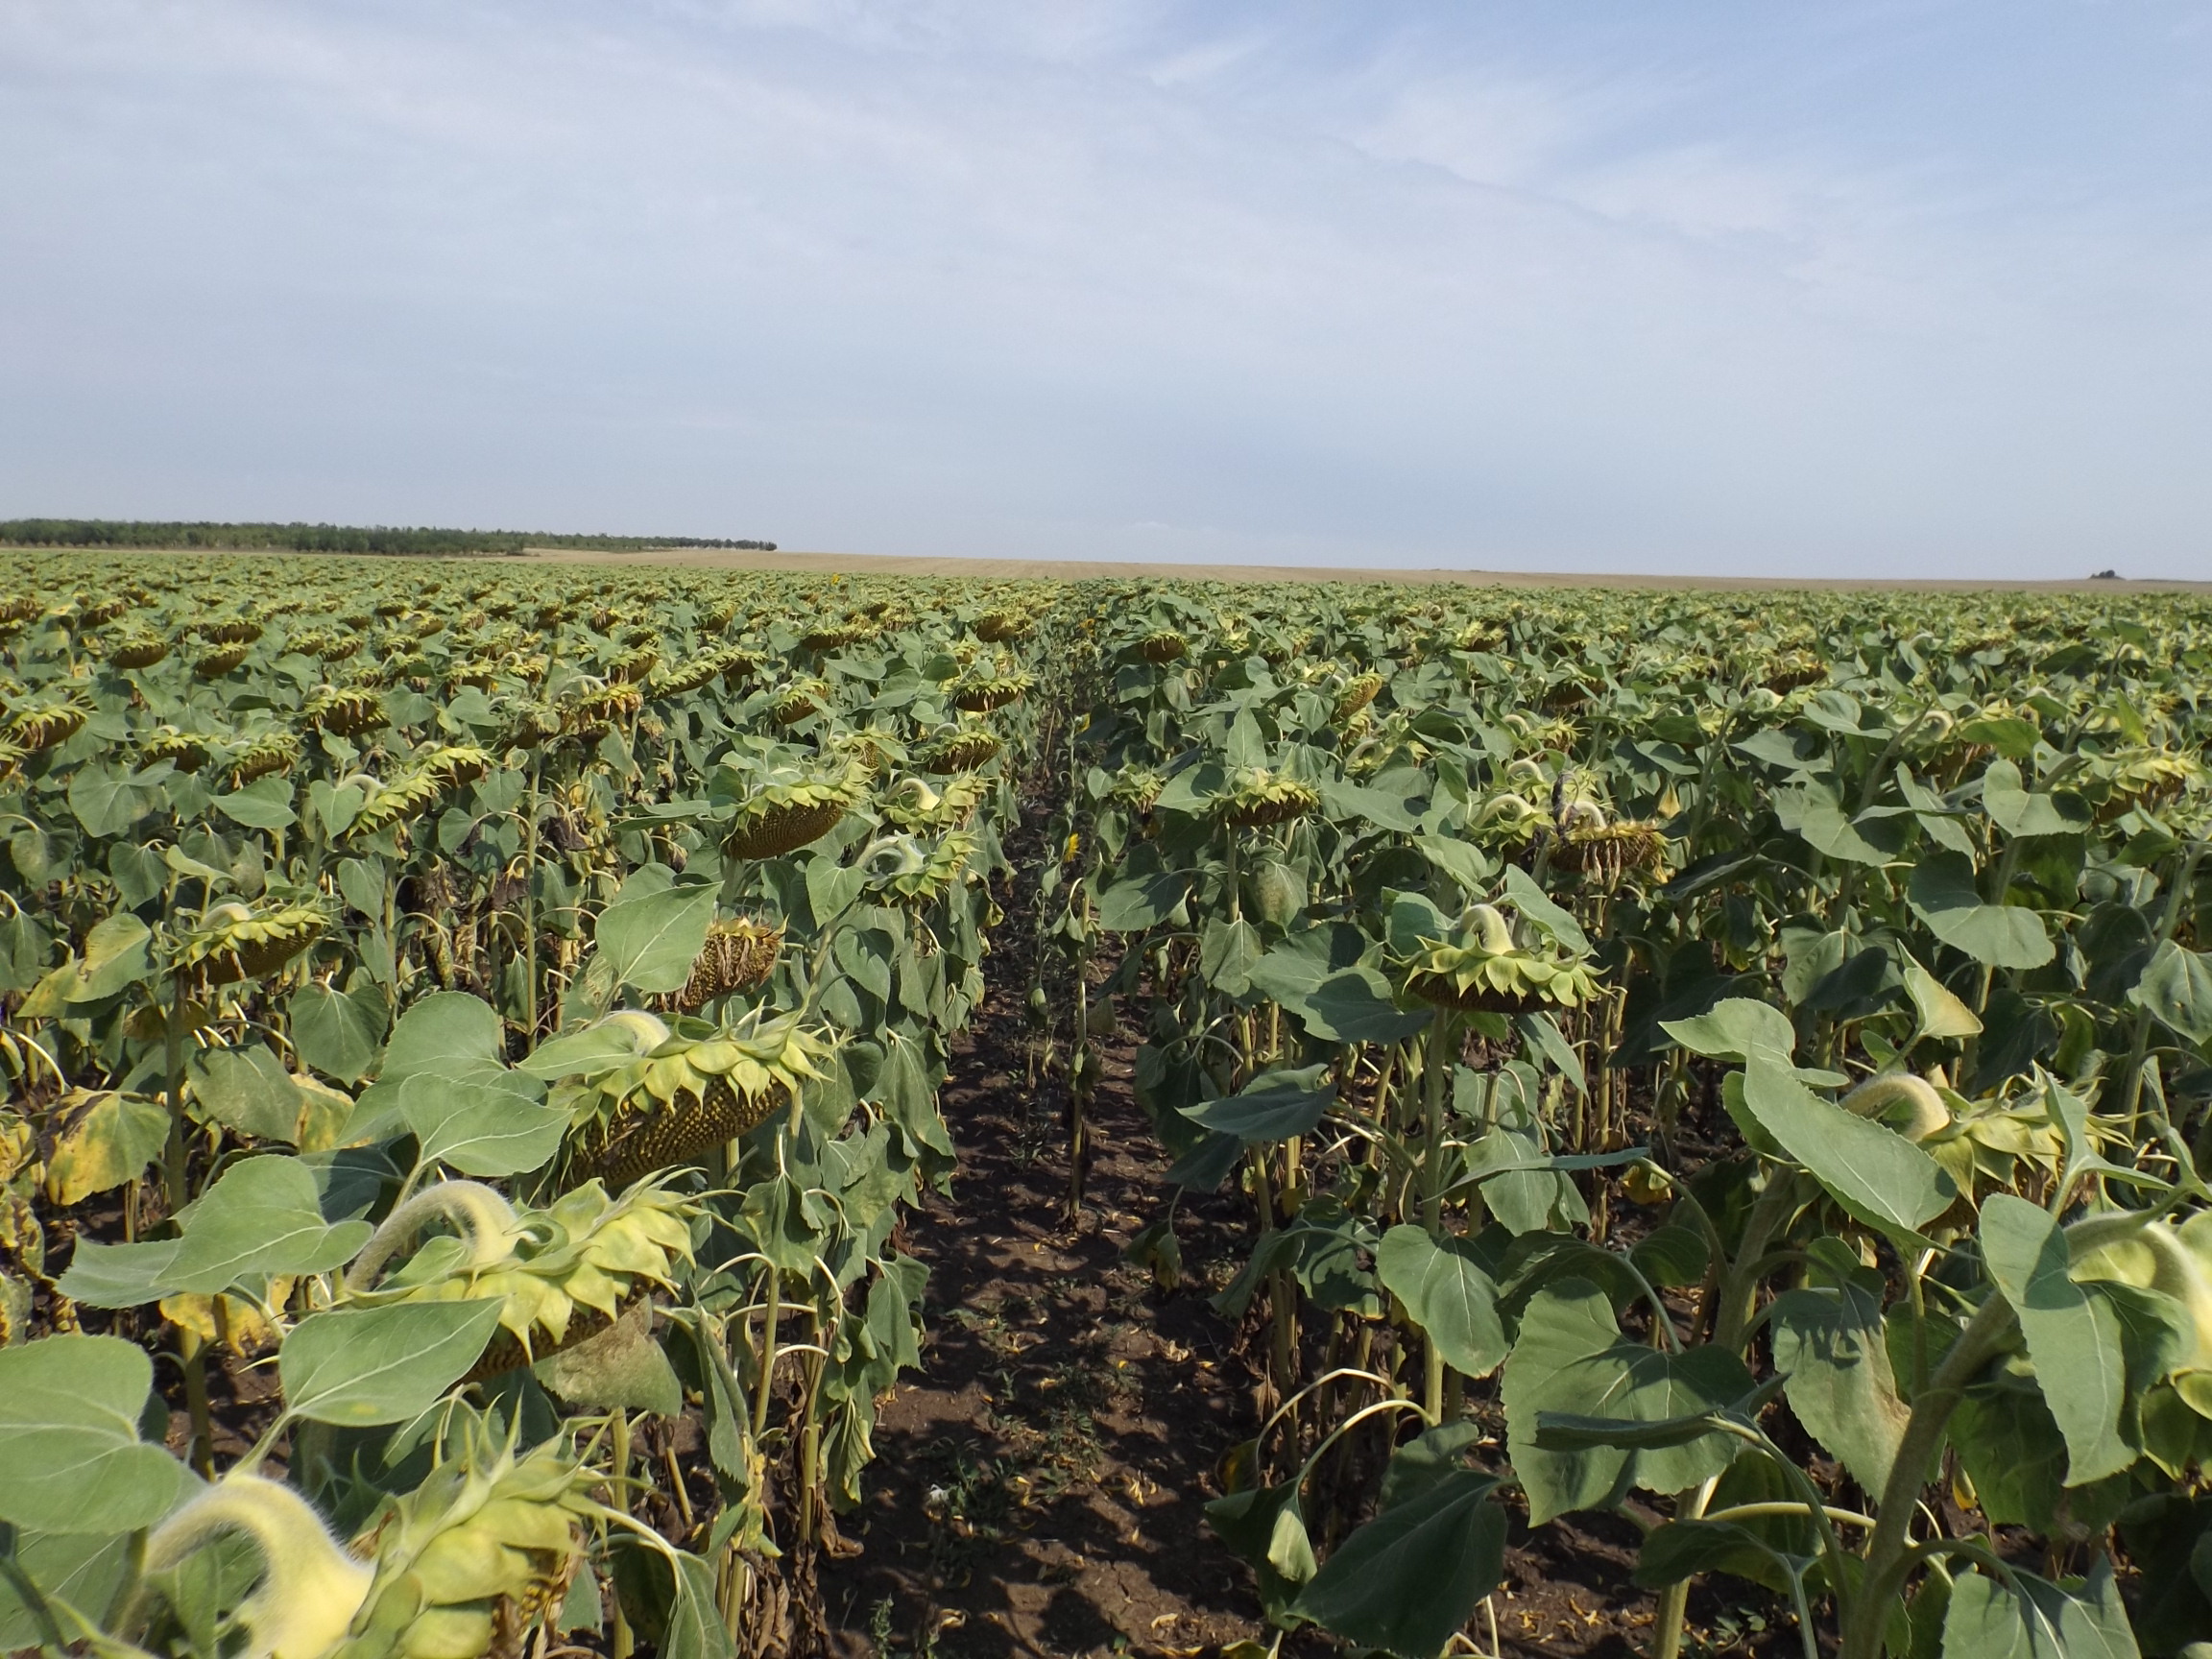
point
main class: Cropland
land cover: Sunflower
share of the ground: > 75 %
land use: Agriculture (excluding fallow land and kitchen gardens)
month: July
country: BG
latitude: 43.4881
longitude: 27.4276
